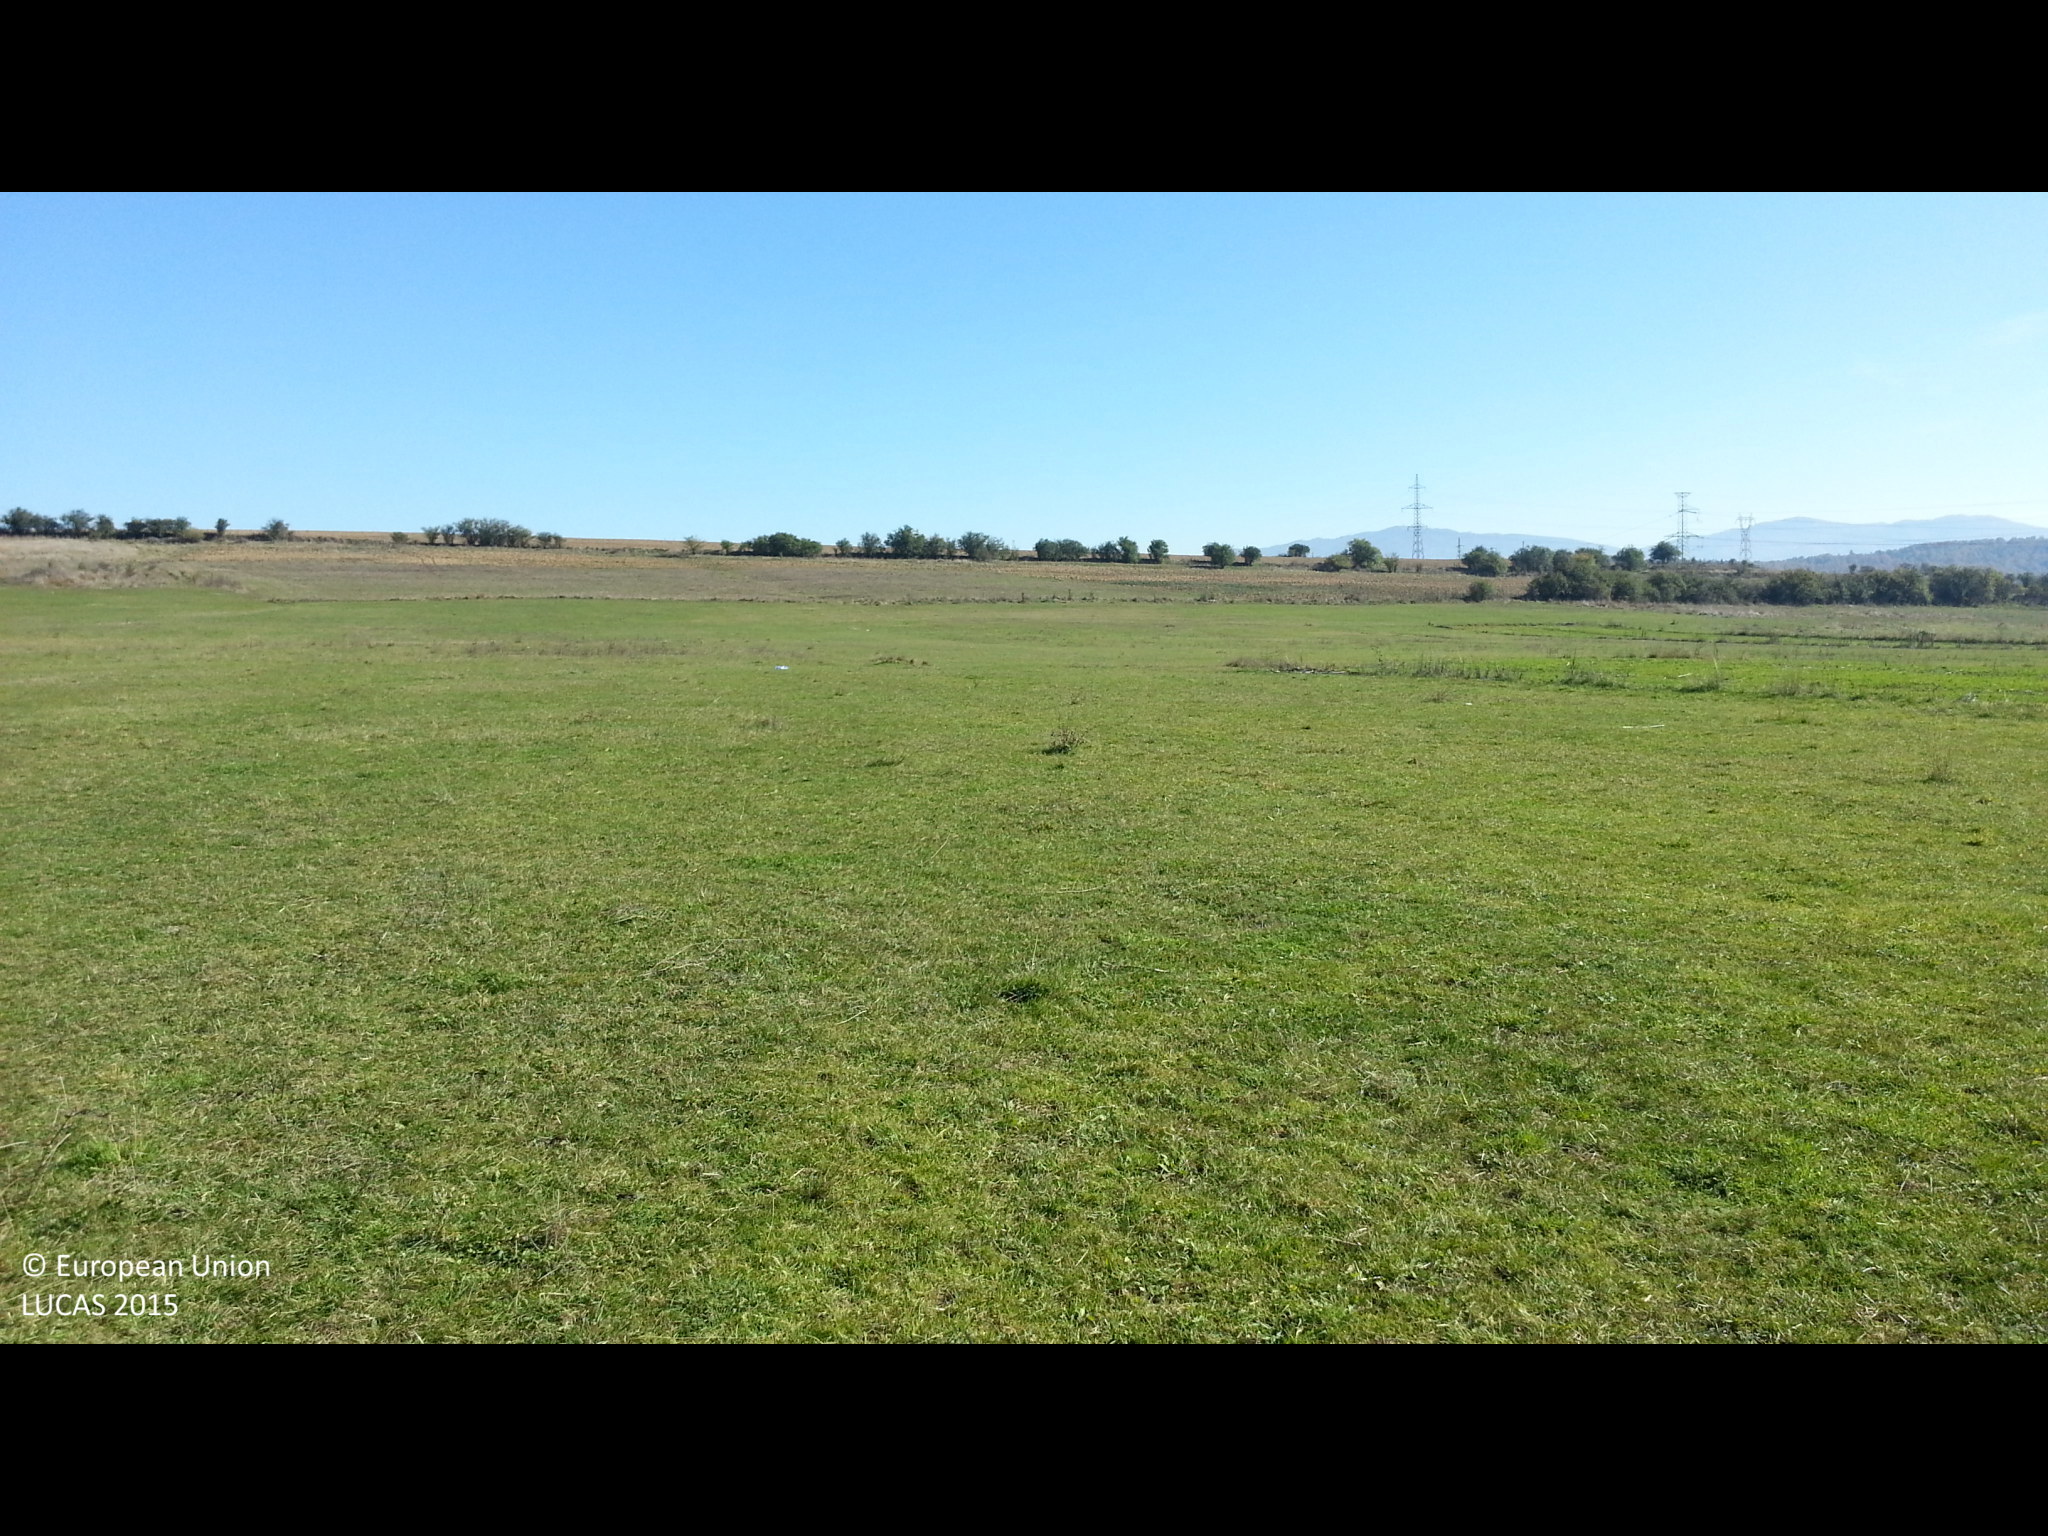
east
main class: Grassland
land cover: Grassland without tree/shrub cover
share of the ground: > 75 %
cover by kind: herbaceous plants 100 %
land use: Agriculture (excluding fallow land and kitchen gardens)
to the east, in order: Grassland without tree/shrub cover; Tracks; Grassland without tree/shrub cover; Common wheat
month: November
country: BG
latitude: 42.6835
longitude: 23.9940
